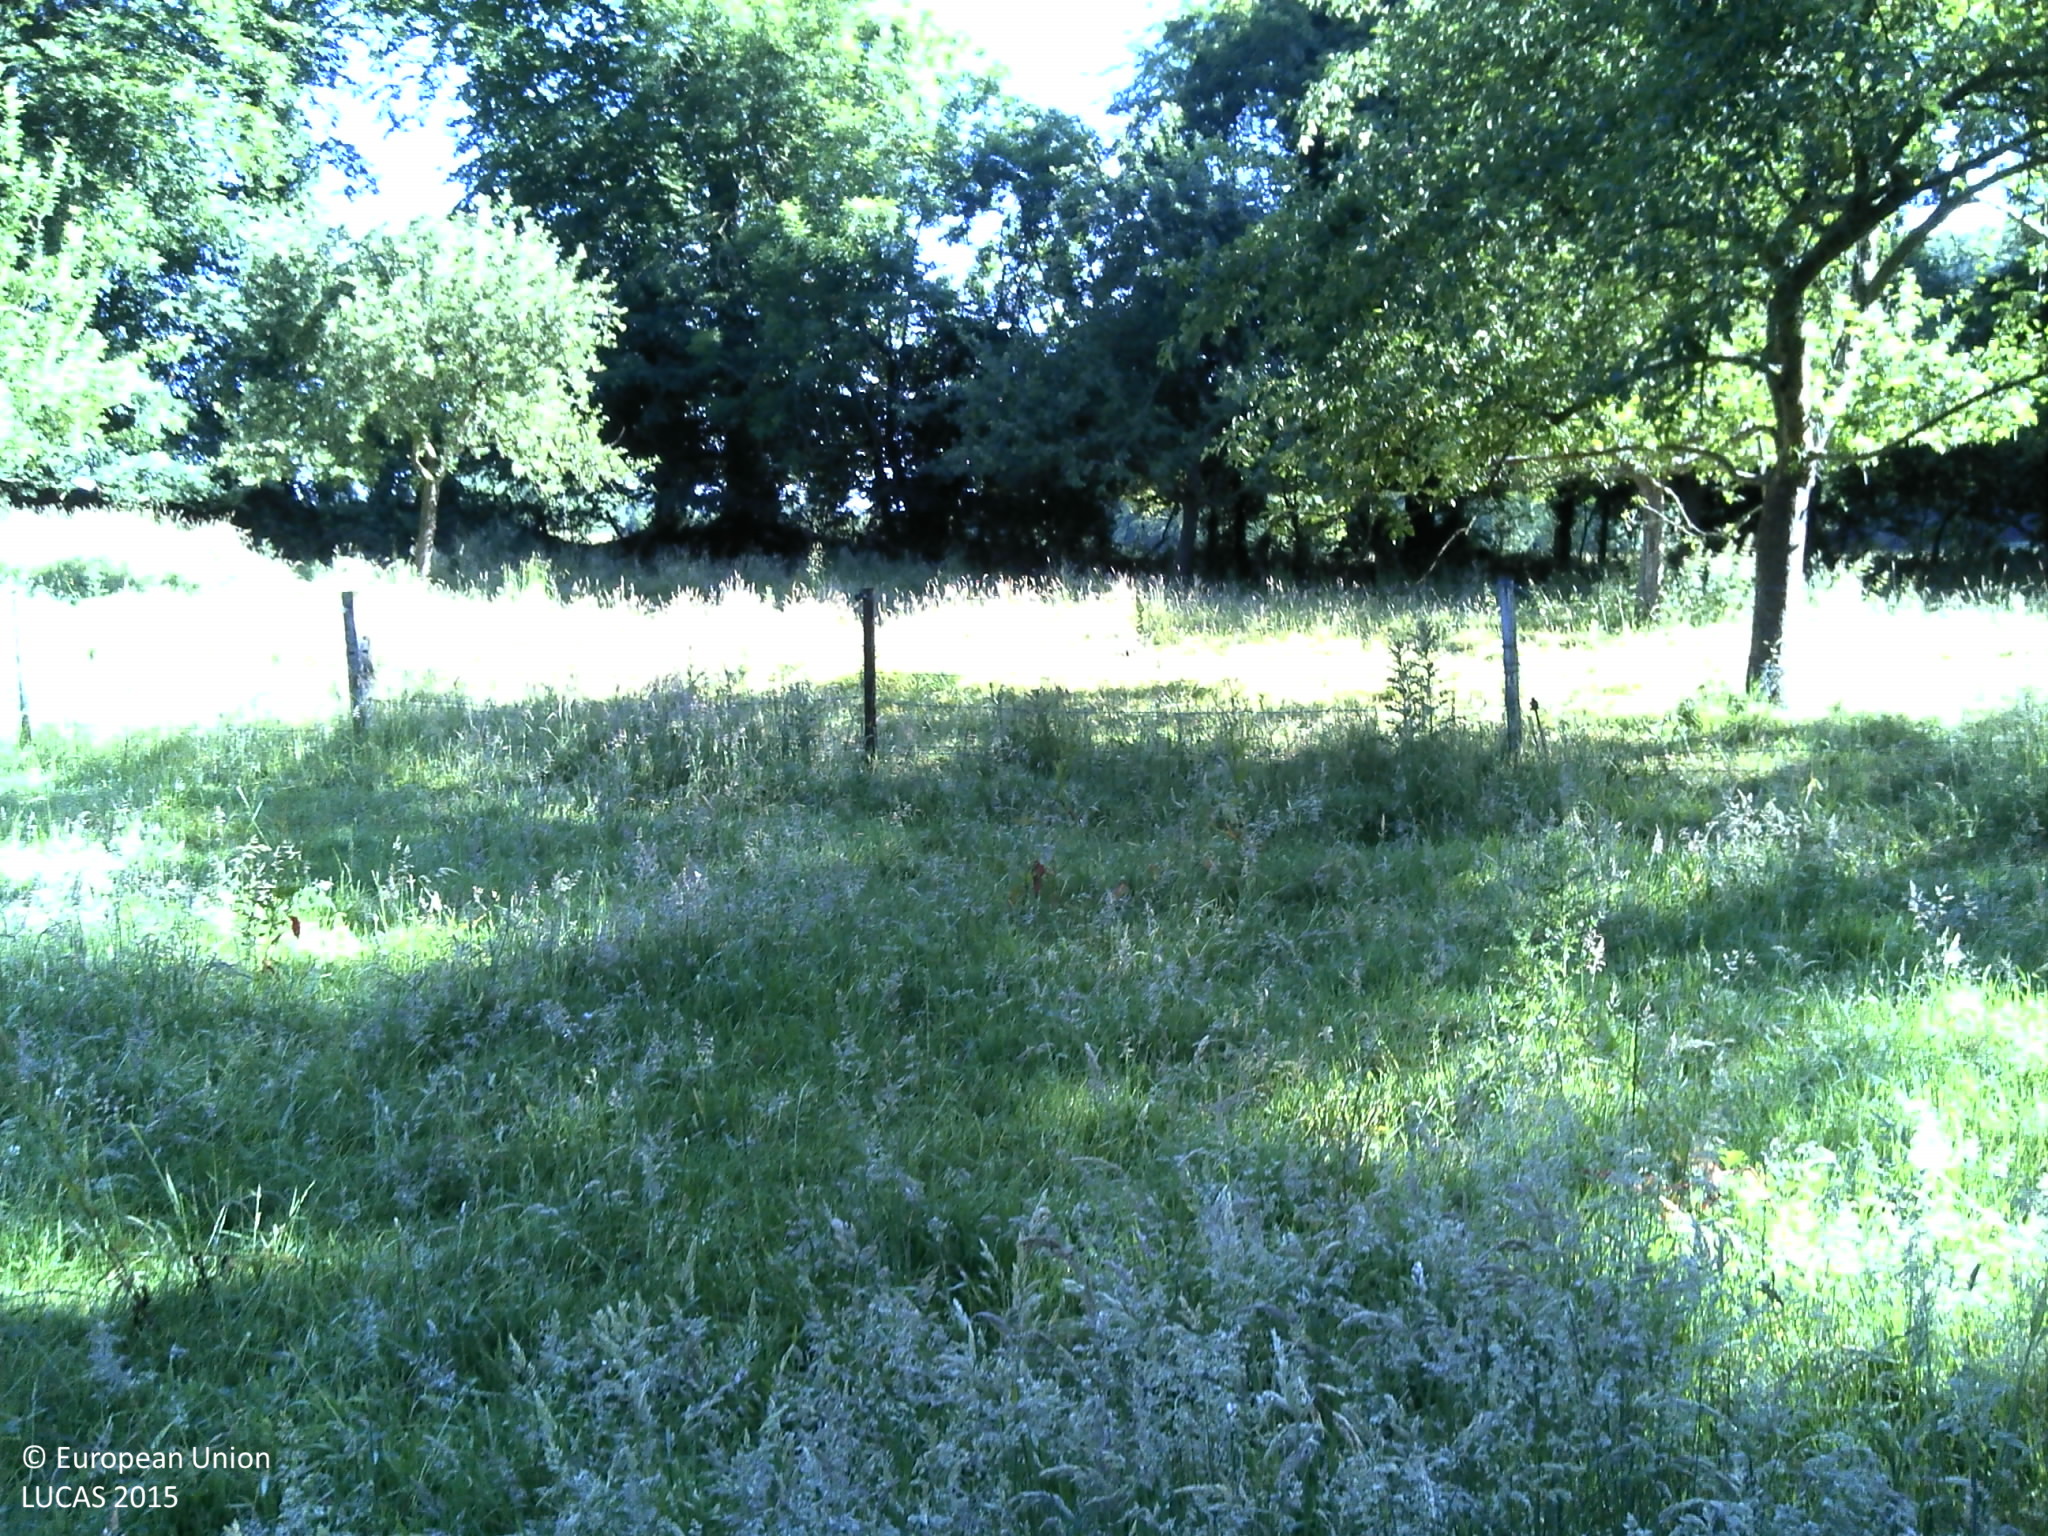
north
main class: Grassland
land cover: Grassland without tree/shrub cover
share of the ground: > 75 %
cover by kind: herbaceous plants 100 %
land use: Agriculture (excluding fallow land and kitchen gardens)
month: June
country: FR
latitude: 49.8085
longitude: 0.9866
